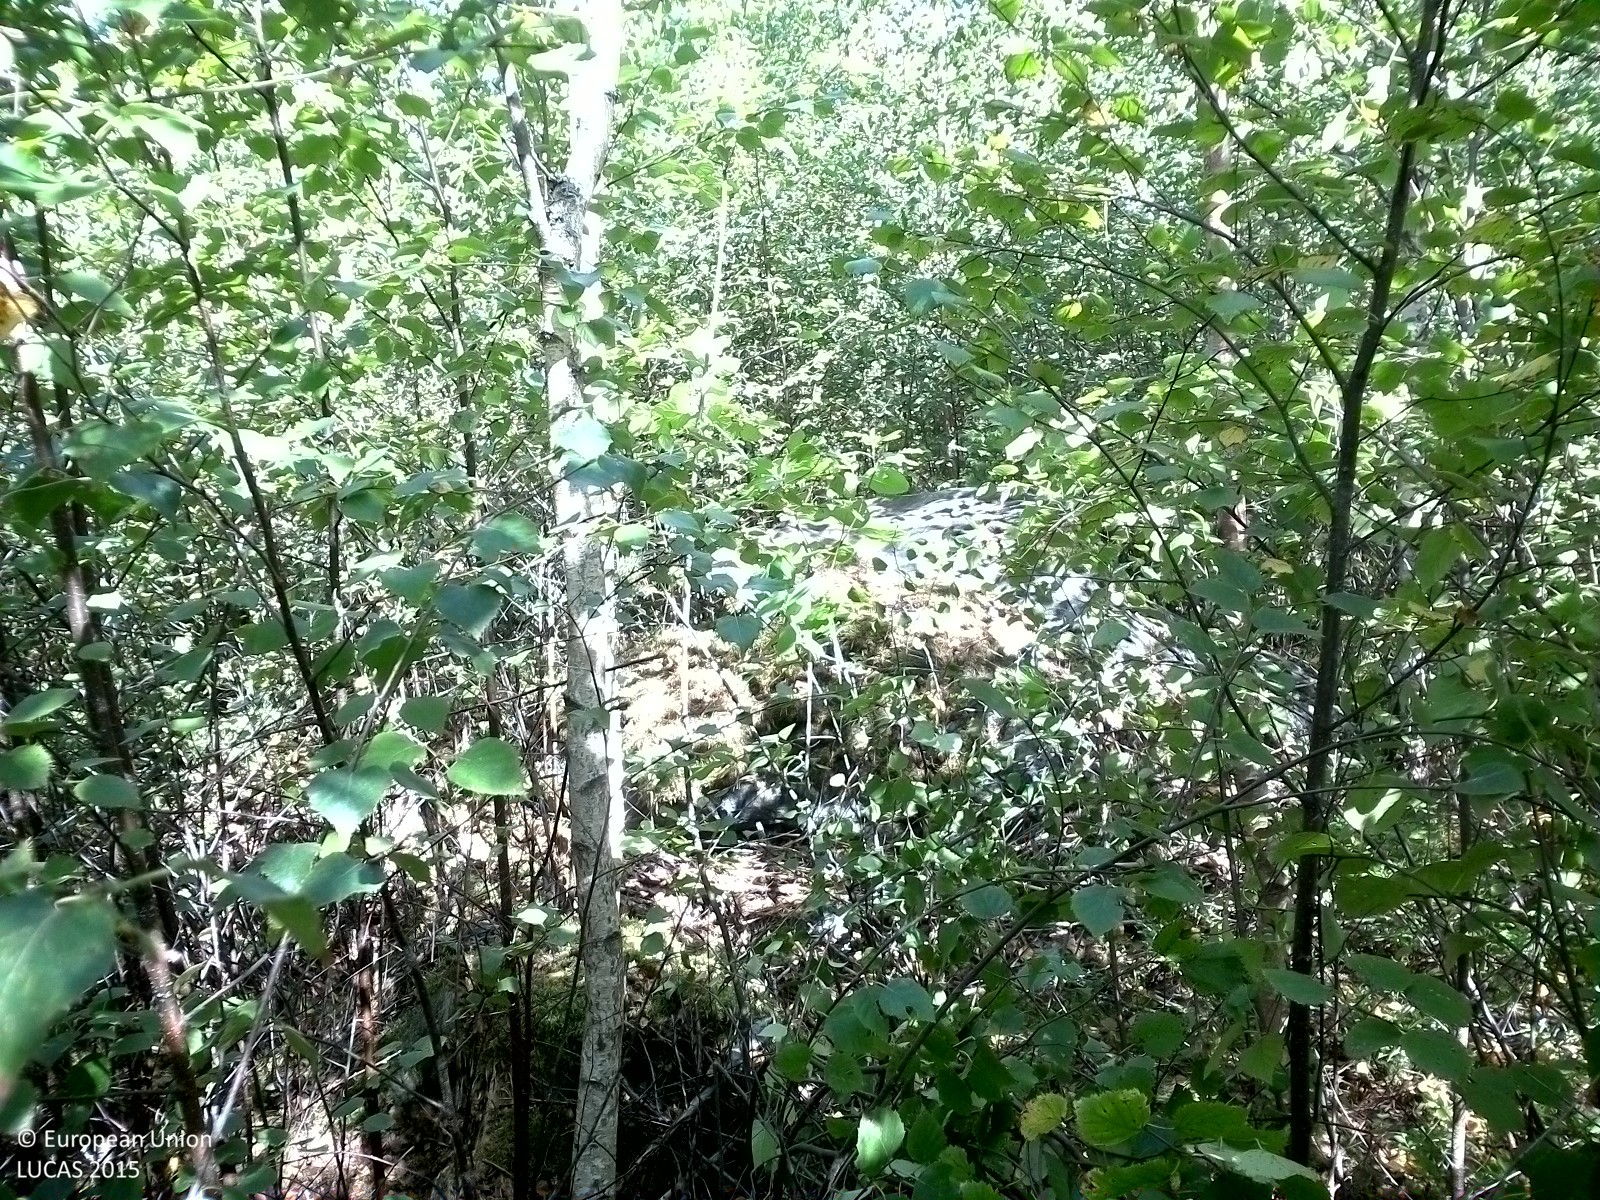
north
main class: Woodland
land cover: Broadleaved woodland
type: hemiboreal forest and nemoral coniferous forest and mixed broadleaved-coniferous forest
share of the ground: > 75 %
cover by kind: broadleaved forest trees 90 %, herbaceous plants 5 %, unconsolidated bare surface 5 %
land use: Forestry
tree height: < 5 m
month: August
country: SE
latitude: 59.2469
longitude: 15.4096
